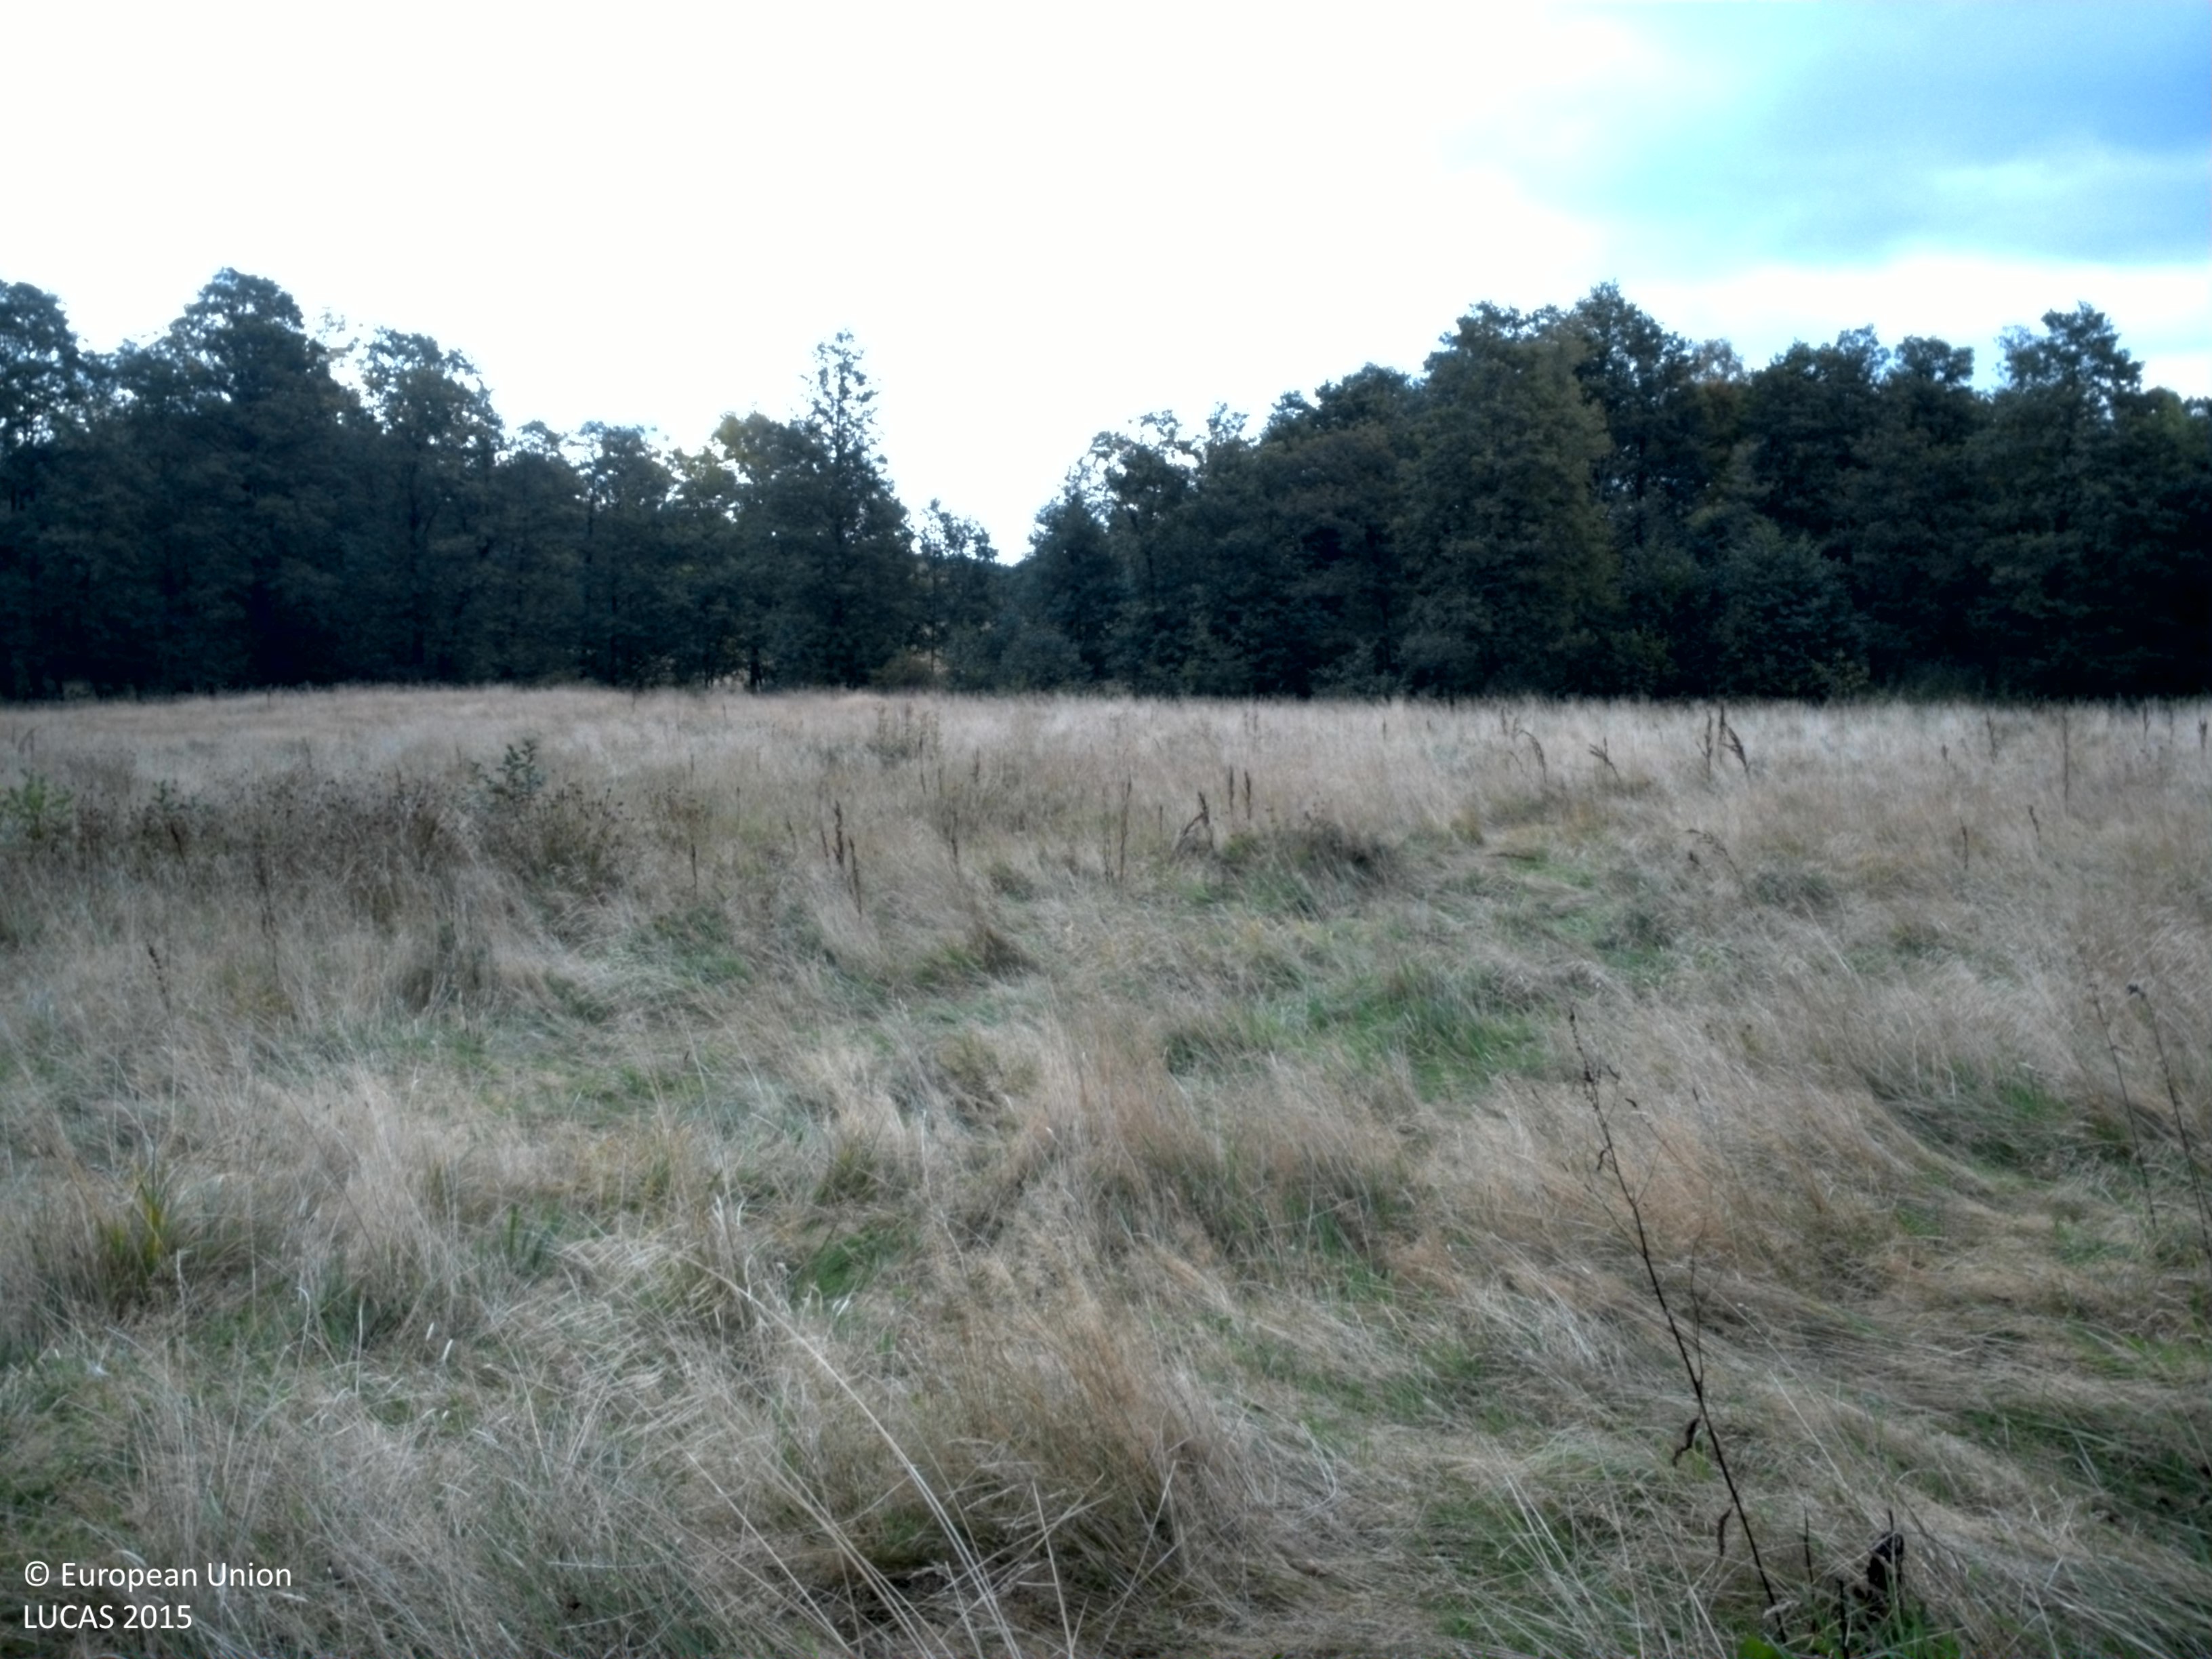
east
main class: Grassland
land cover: Grassland without tree/shrub cover
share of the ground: > 75 %
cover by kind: herbaceous plants 100 %
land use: Agriculture (excluding fallow land and kitchen gardens)
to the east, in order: Grassland without tree/shrub cover; Broadleaved woodland; Grassland without tree/shrub cover; Dry stone walls; Groves; Grassland without tree/shrub cover; Fences; Grass margins; Maize; Electric lines; Maize
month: October
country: SE
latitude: 55.6148
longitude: 14.2060
